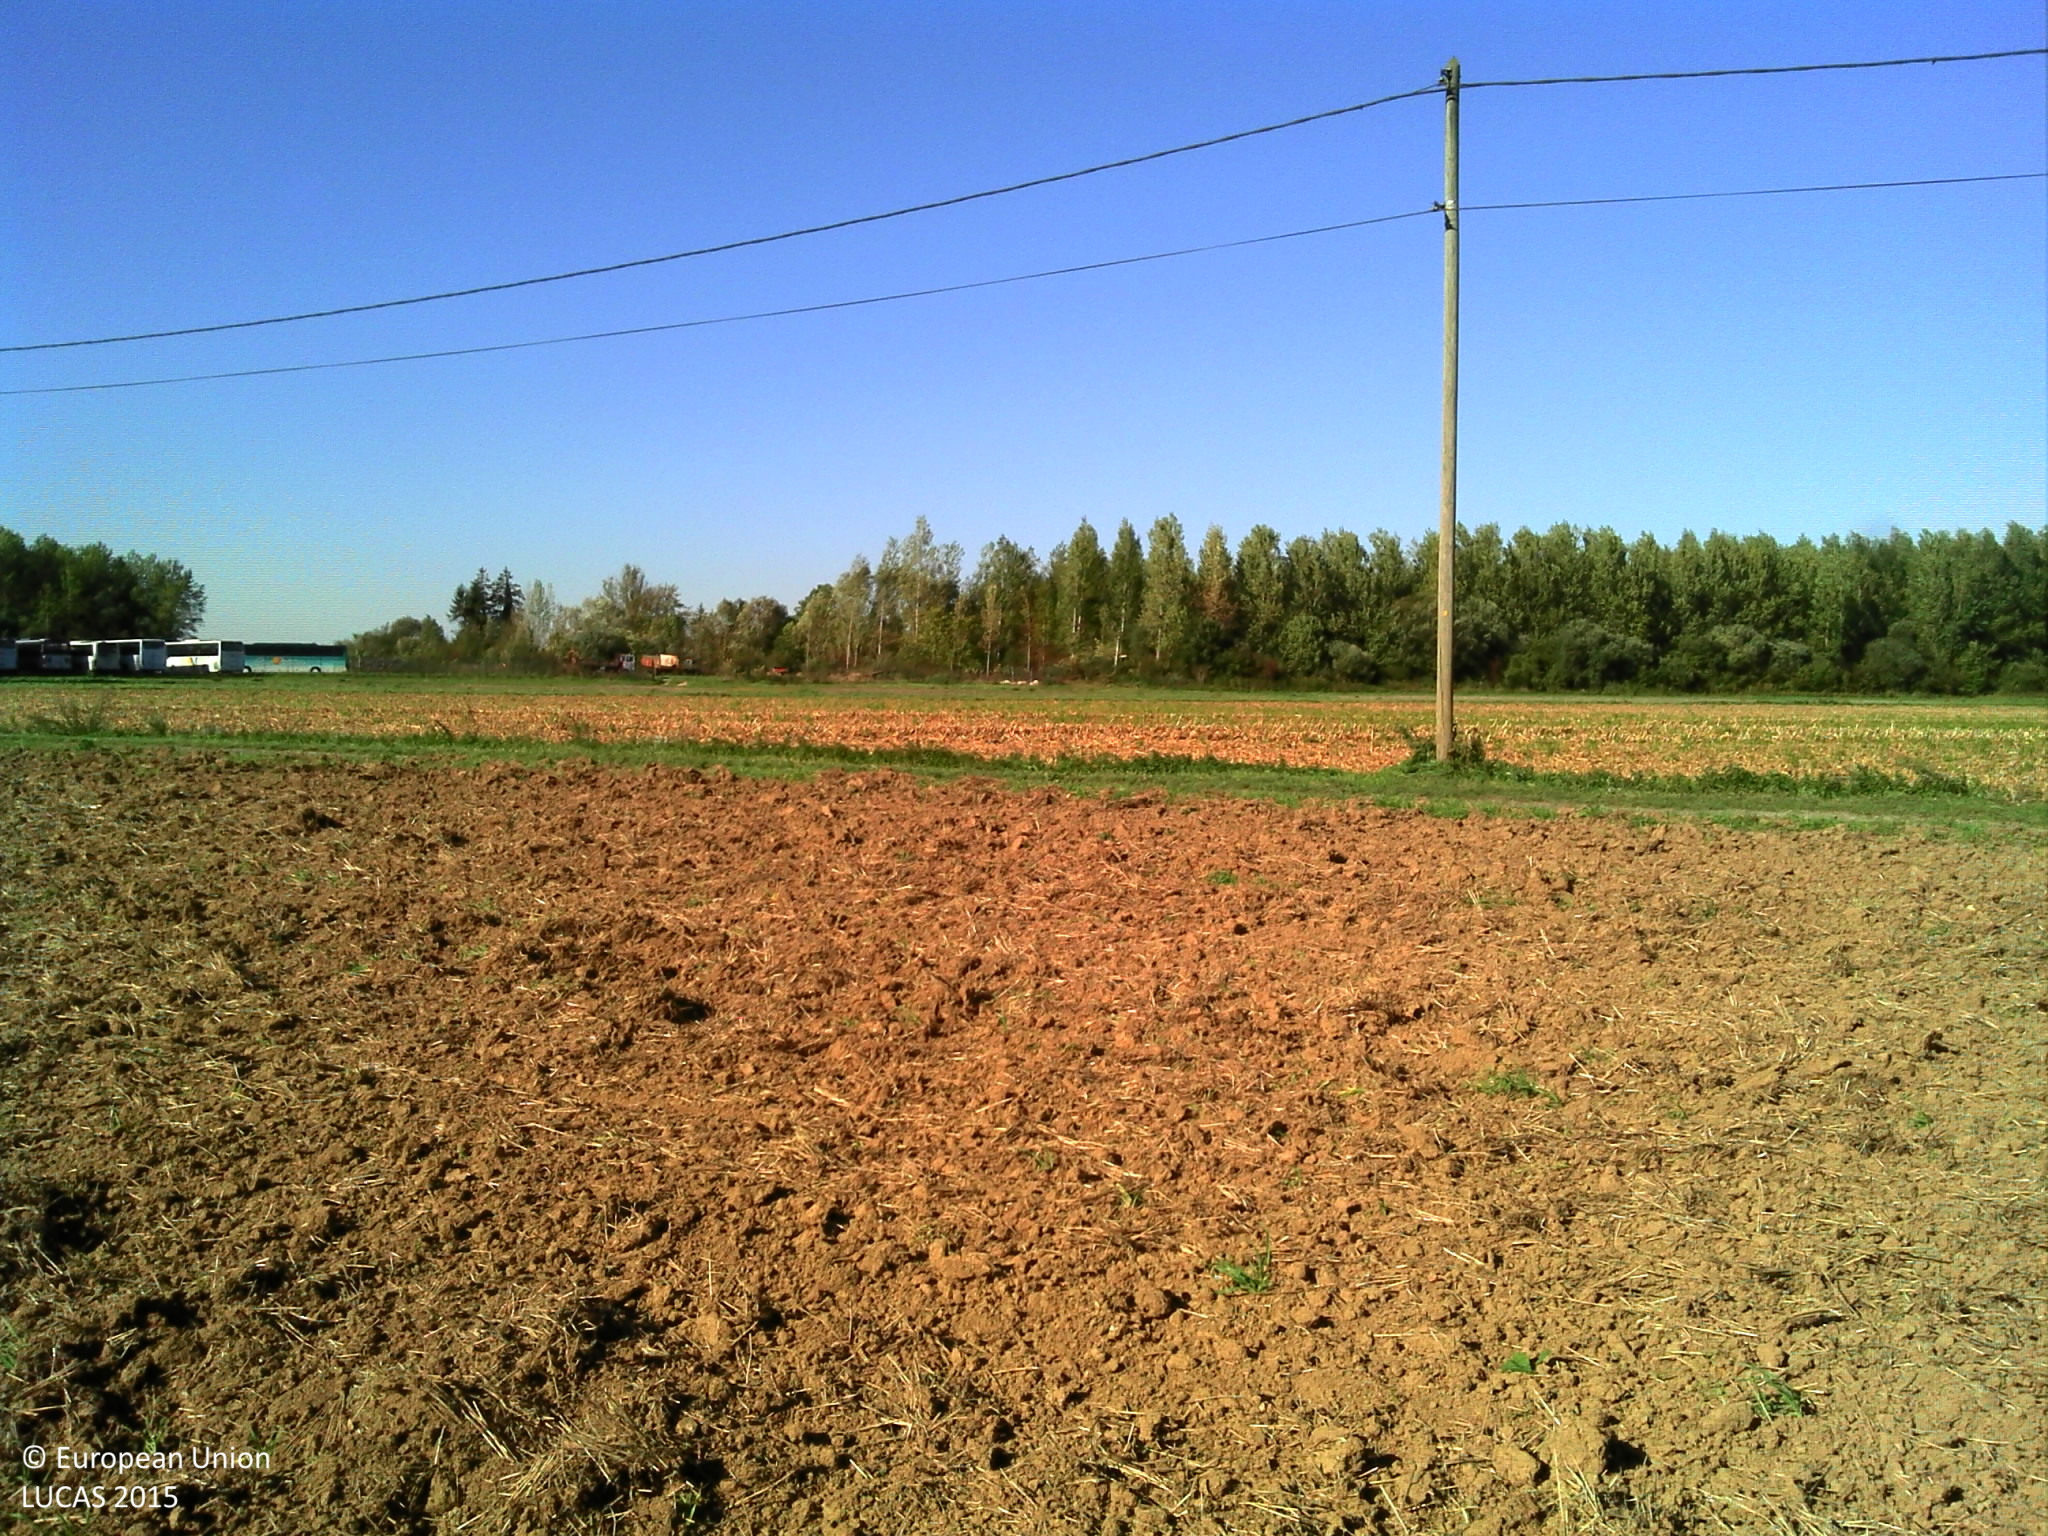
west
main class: Cropland
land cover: Common wheat
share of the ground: < 10 %
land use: Agriculture (excluding fallow land and kitchen gardens)
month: September
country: FR
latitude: 48.4220
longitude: 3.3858
